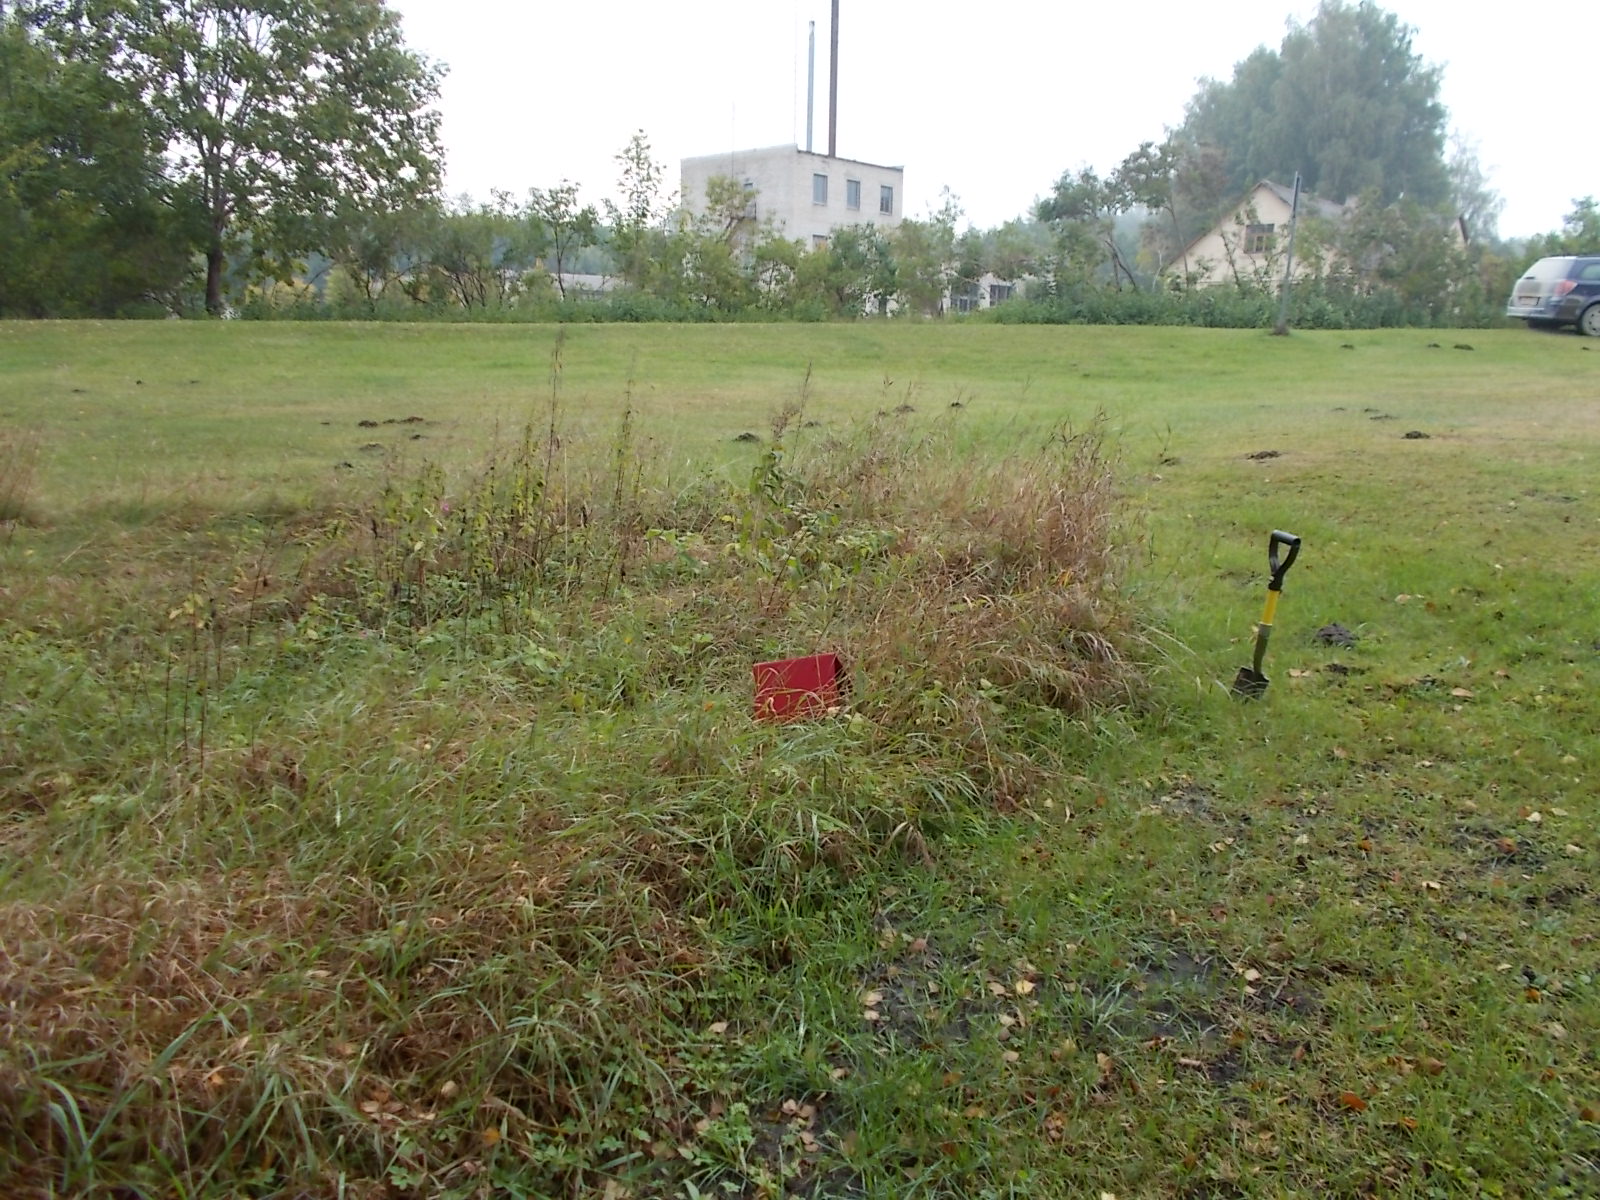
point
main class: Grassland
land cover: Spontaneously vegetated surfaces
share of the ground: > 75 %
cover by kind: herbaceous plants 100 %
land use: Residential
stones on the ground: < 10 %
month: September
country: LV
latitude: 57.3278
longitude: 22.2574
